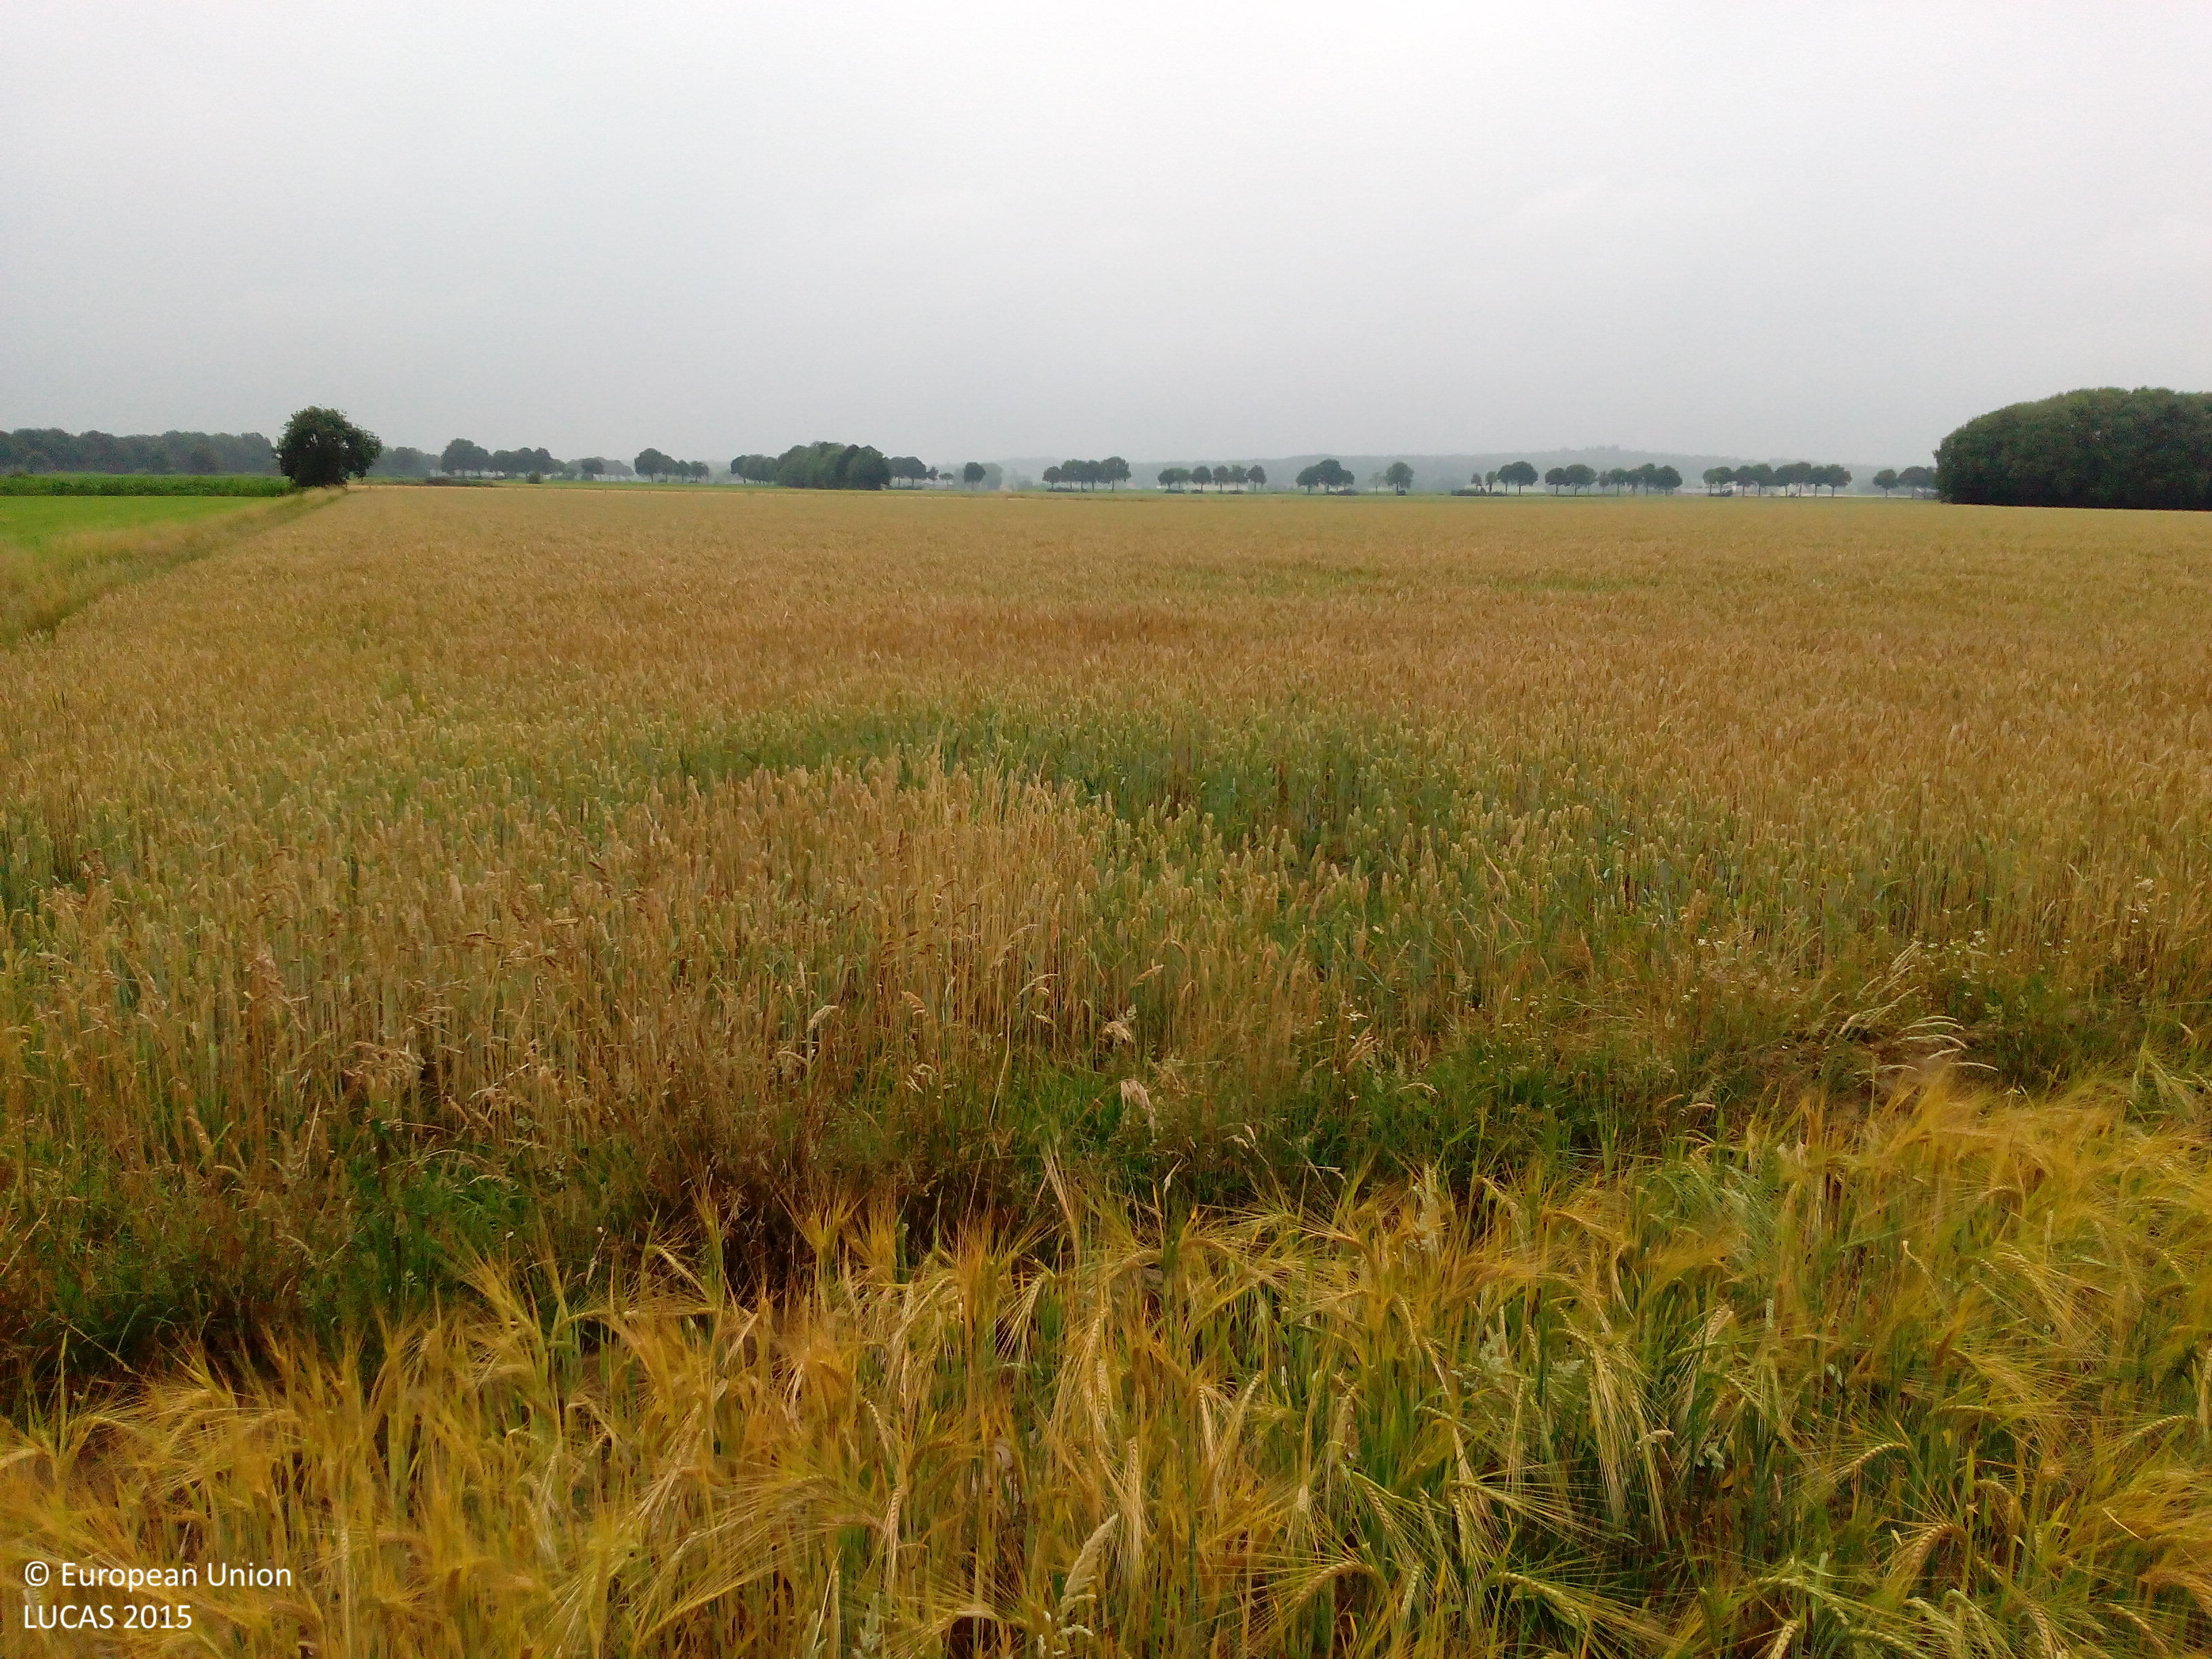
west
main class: Cropland
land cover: Barley
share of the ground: > 75 %
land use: Agriculture (excluding fallow land and kitchen gardens)
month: July
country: NL
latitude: 51.8878
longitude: 6.2944
